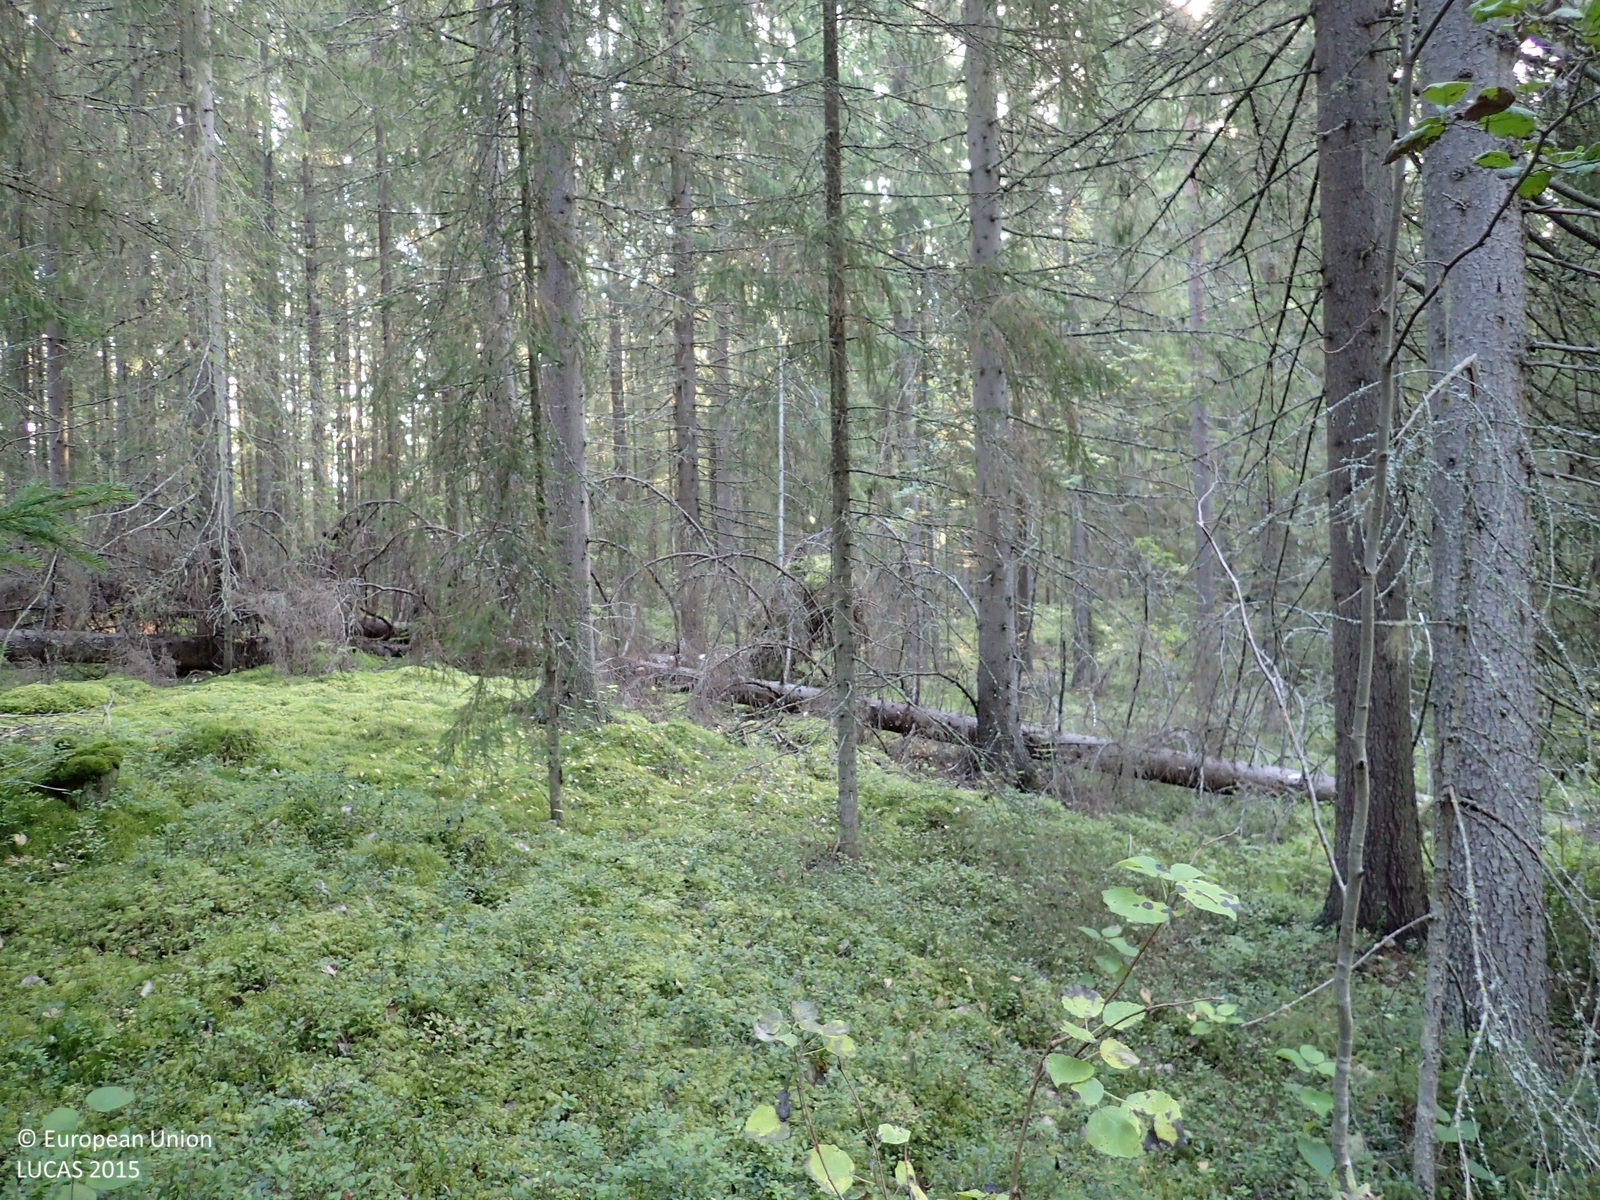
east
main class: Woodland
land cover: Spruce dominated coniferous woodland
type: boreal forest
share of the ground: > 75 %
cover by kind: coniferous forest trees 75 %, shrubs 15 %, broadleaved forest trees 5 %, lichens and mosses 5 %
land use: Forestry
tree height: > 5 m
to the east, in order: Spruce dominated coniferous woodland; Broadleaved woodland; Ditches and canals; Broadleaved woodland
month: September
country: FI
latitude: 63.0746
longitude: 25.6884
